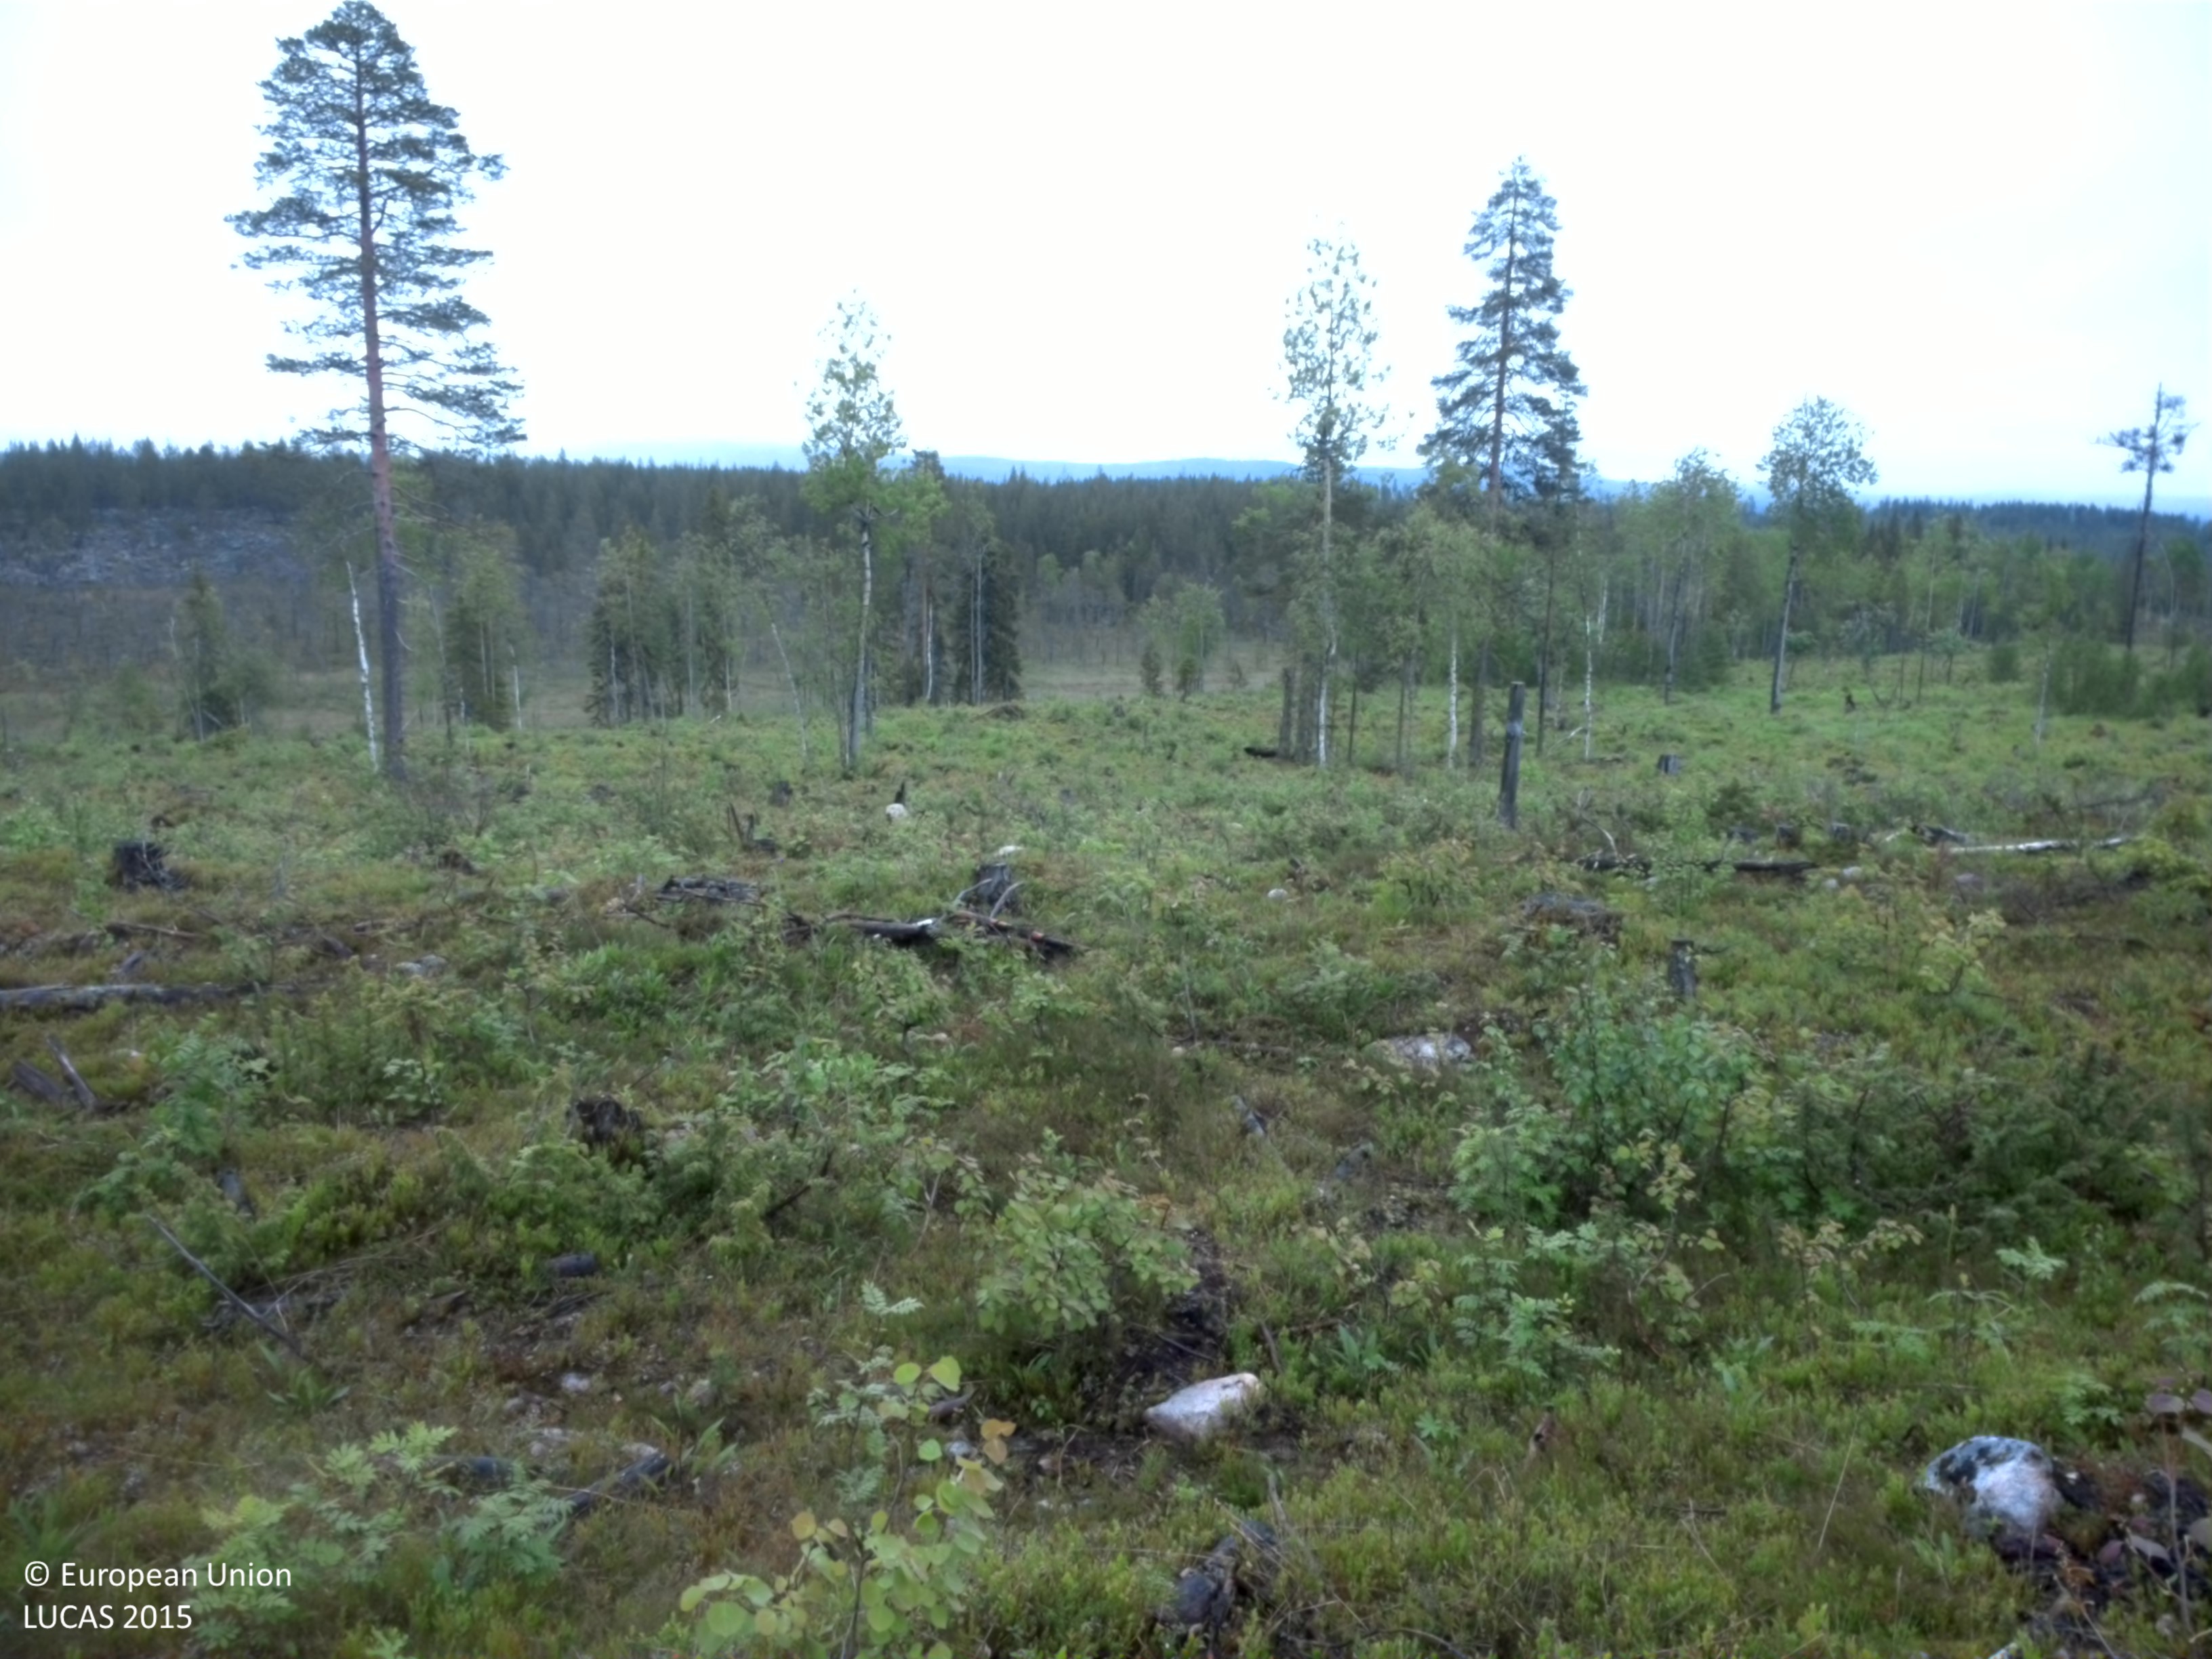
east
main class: Woodland
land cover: Broadleaved woodland
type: boreal forest
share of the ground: 10 - 25 %
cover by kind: shrubs 80 %, broadleaved forest trees 15 %, consolidated bare surface 5 %
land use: Forestry
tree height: < 5 m
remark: Clear cut
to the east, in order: Broadleaved woodland; Other mixed woodland; Peatbogs; Pine dominated coniferous woodland
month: June
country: SE
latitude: 66.5212
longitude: 22.8185
